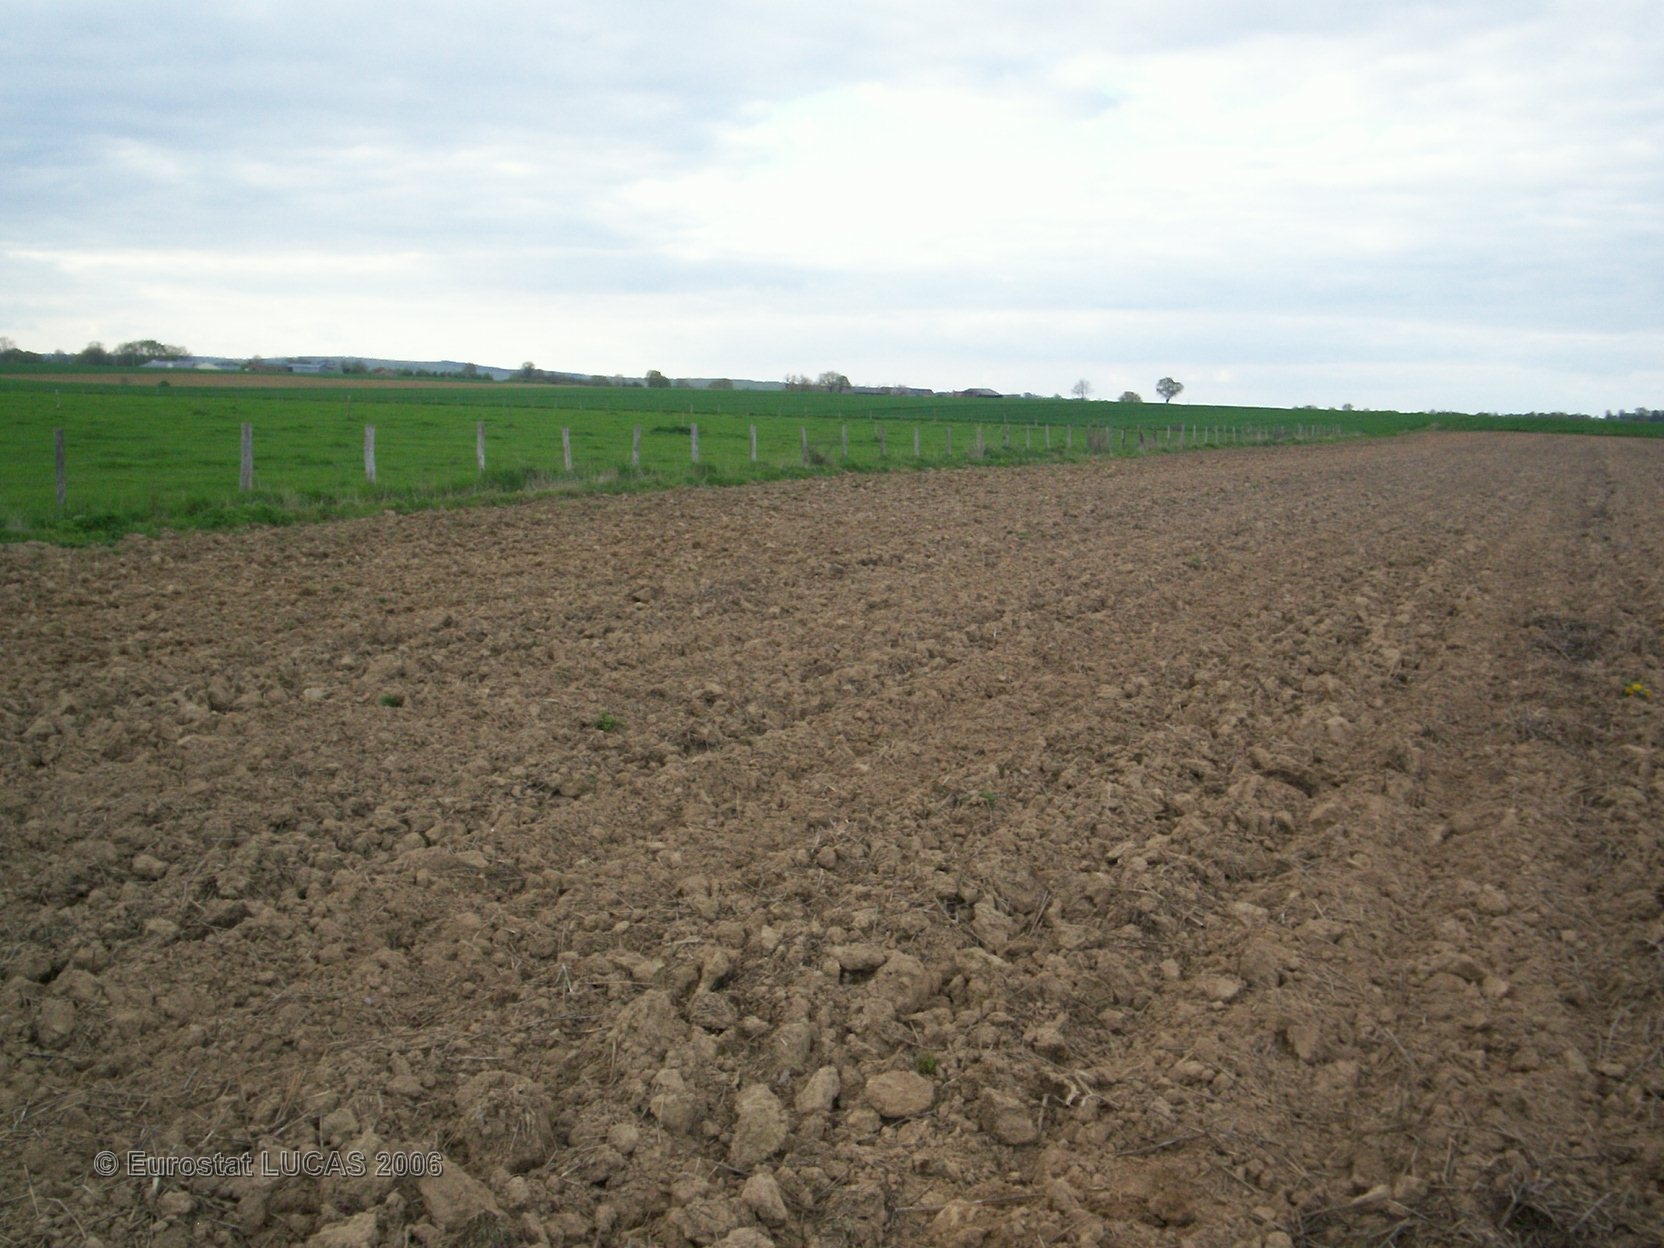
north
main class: Cropland
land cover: Maize
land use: Agriculture (excluding fallow land and kitchen gardens)
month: May
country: FR
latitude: 48.0206
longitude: -0.2067
